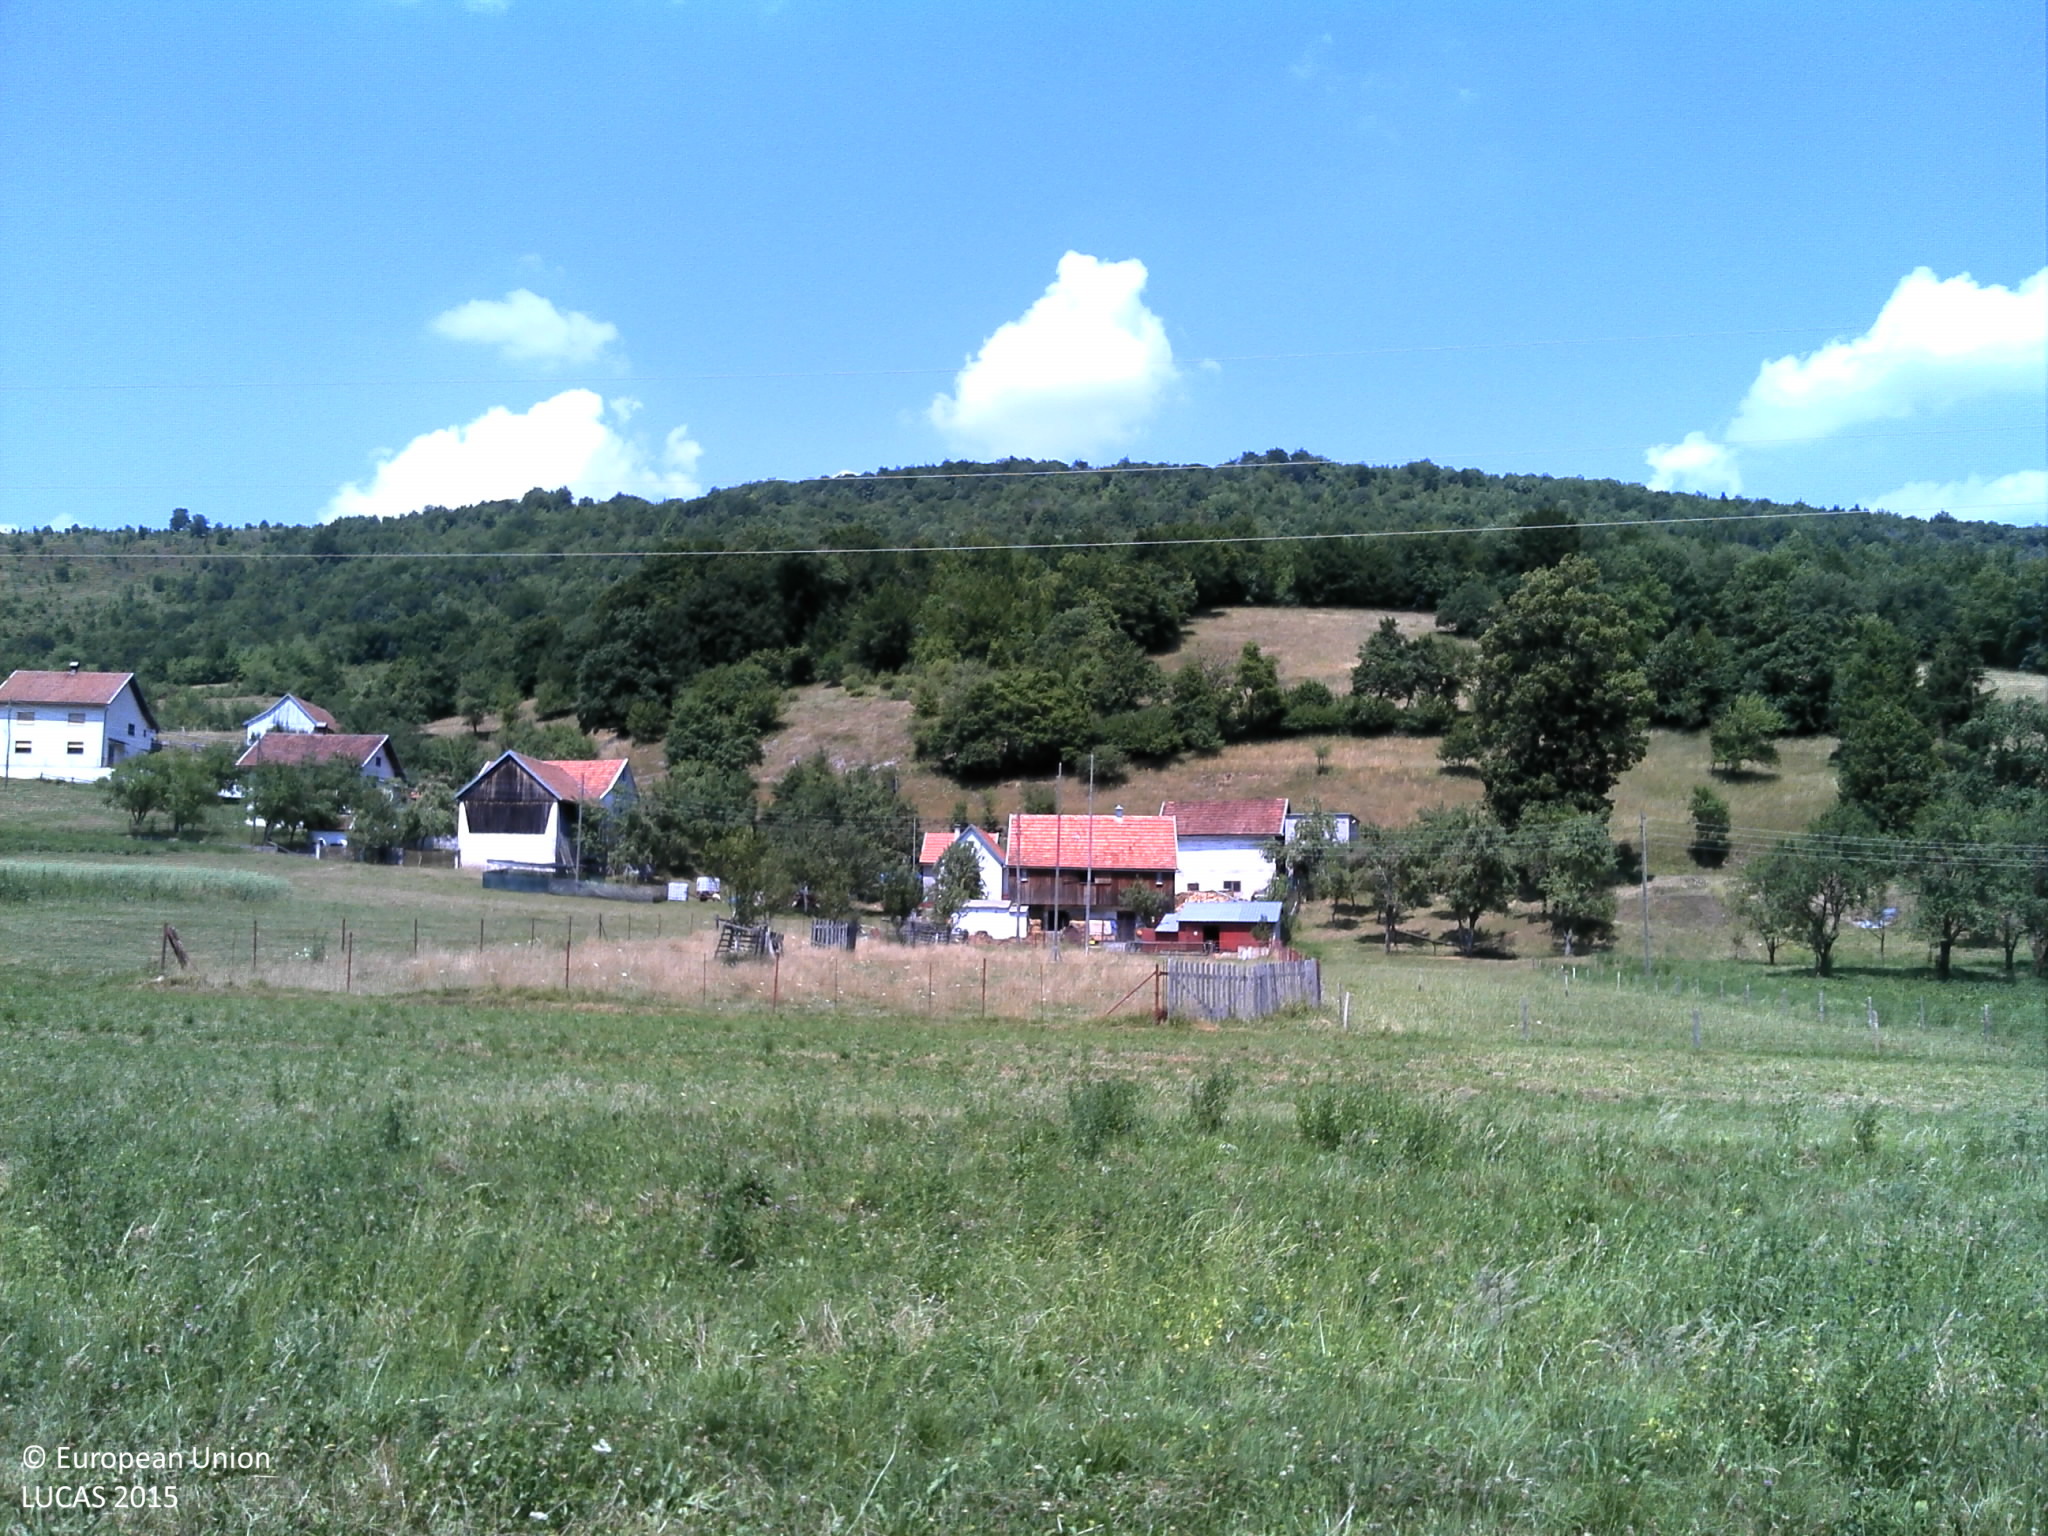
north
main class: Grassland
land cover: Grassland without tree/shrub cover
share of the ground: > 75 %
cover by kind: herbaceous plants 100 %
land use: Agriculture (excluding fallow land and kitchen gardens)
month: July
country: HR
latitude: 44.9774
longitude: 15.2317
